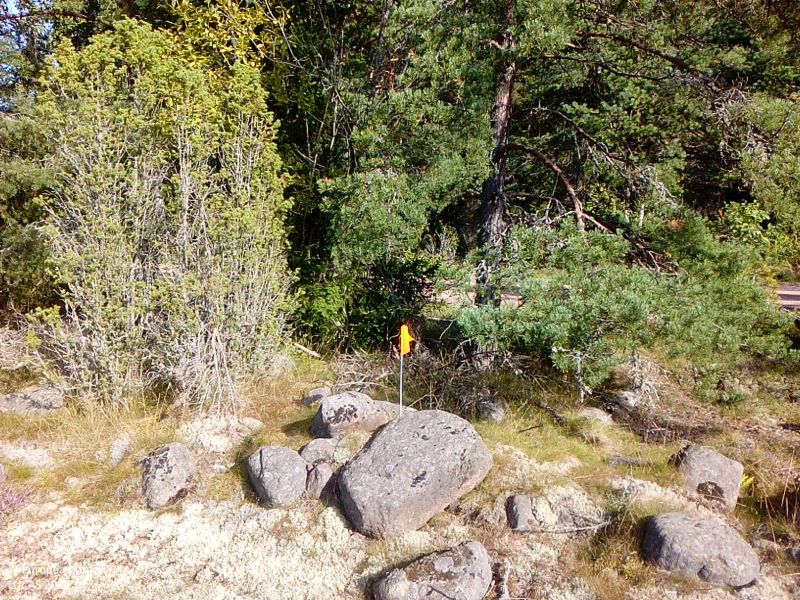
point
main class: Woodland
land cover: Pine dominated coniferous woodland
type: hemiboreal forest and nemoral coniferous forest and mixed broadleaved-coniferous forest
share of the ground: 50 - 75 %
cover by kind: coniferous forest trees 60 %, lichens and mosses 20 %, broadleaved forest trees 10 %, unconsolidated bare surface 10 %
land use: Semi-natural and natural areas not in use
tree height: > 5 m
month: August
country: FI
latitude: 60.2627
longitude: 19.7096
